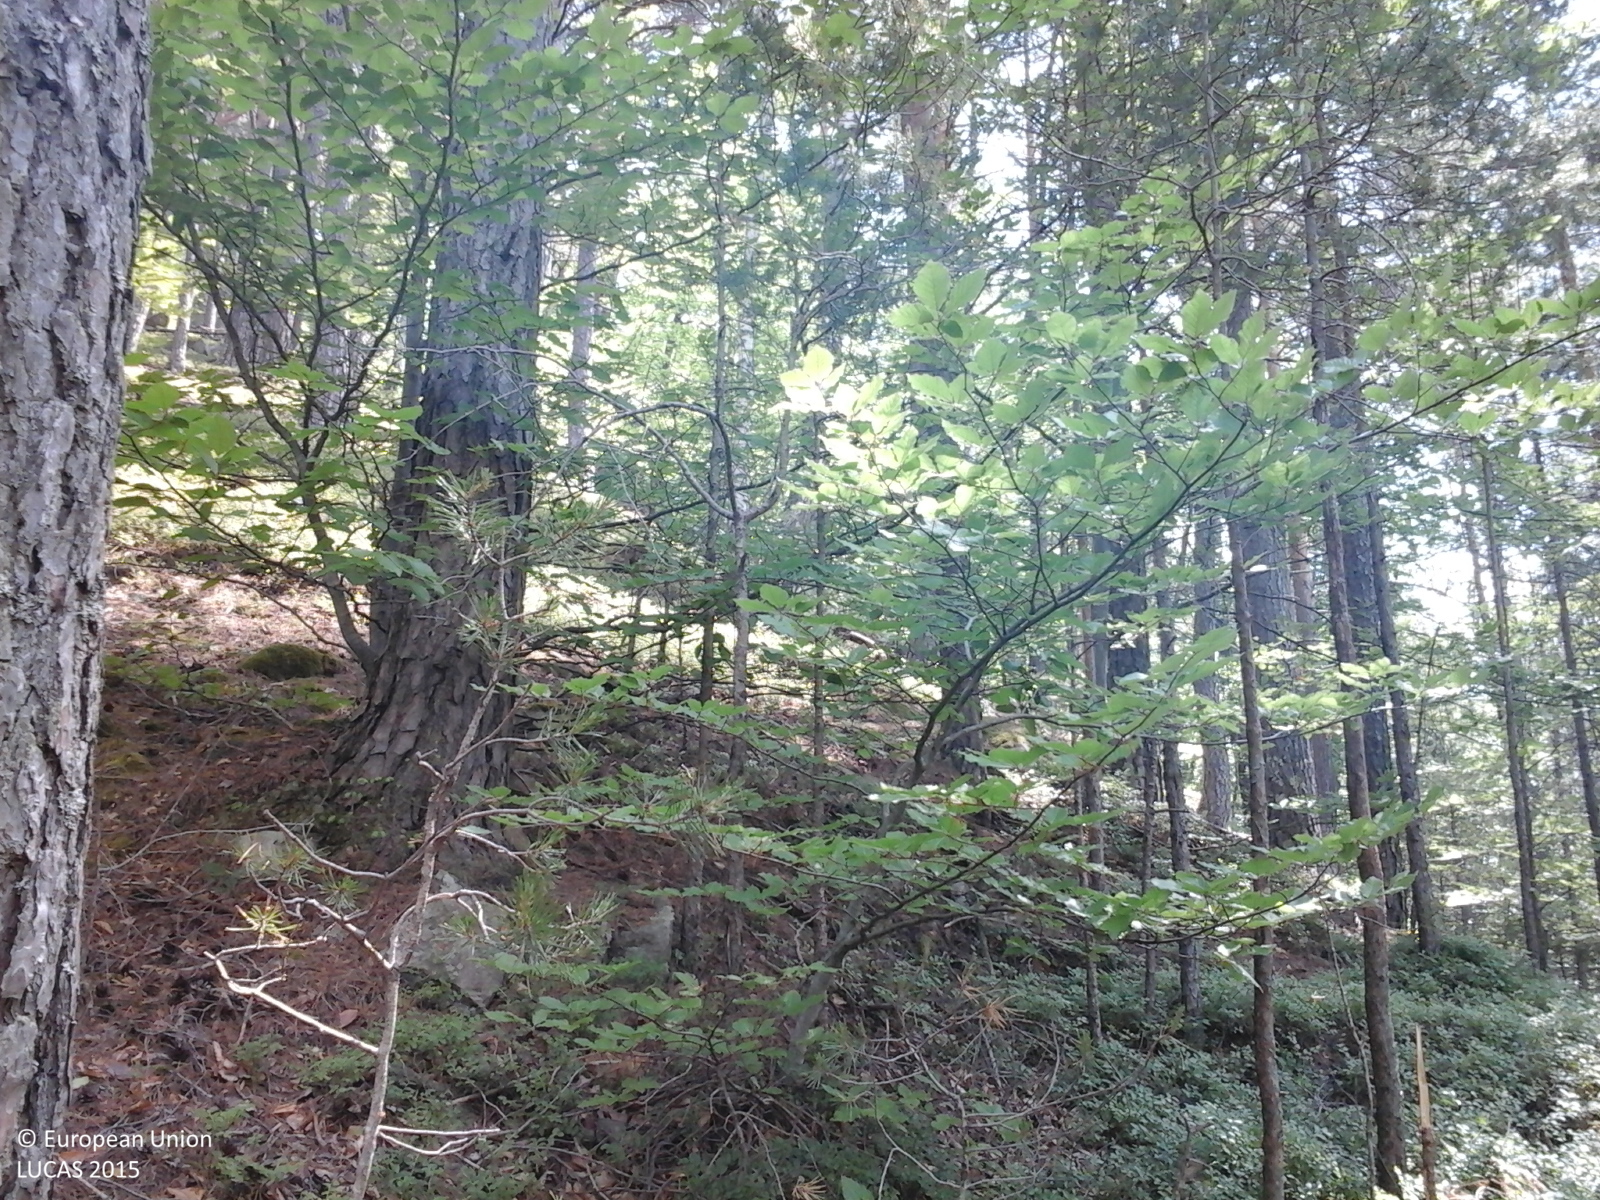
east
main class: Woodland
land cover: Pine dominated mixed woodland
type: alpine coniferous forest
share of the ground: > 75 %
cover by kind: coniferous forest trees 75 %, broadleaved forest trees 25 %
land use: Forestry
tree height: > 5 m
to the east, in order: Pine dominated mixed woodland; Other mixed woodland
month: June
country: RO
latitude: 46.2620
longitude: 26.4386
